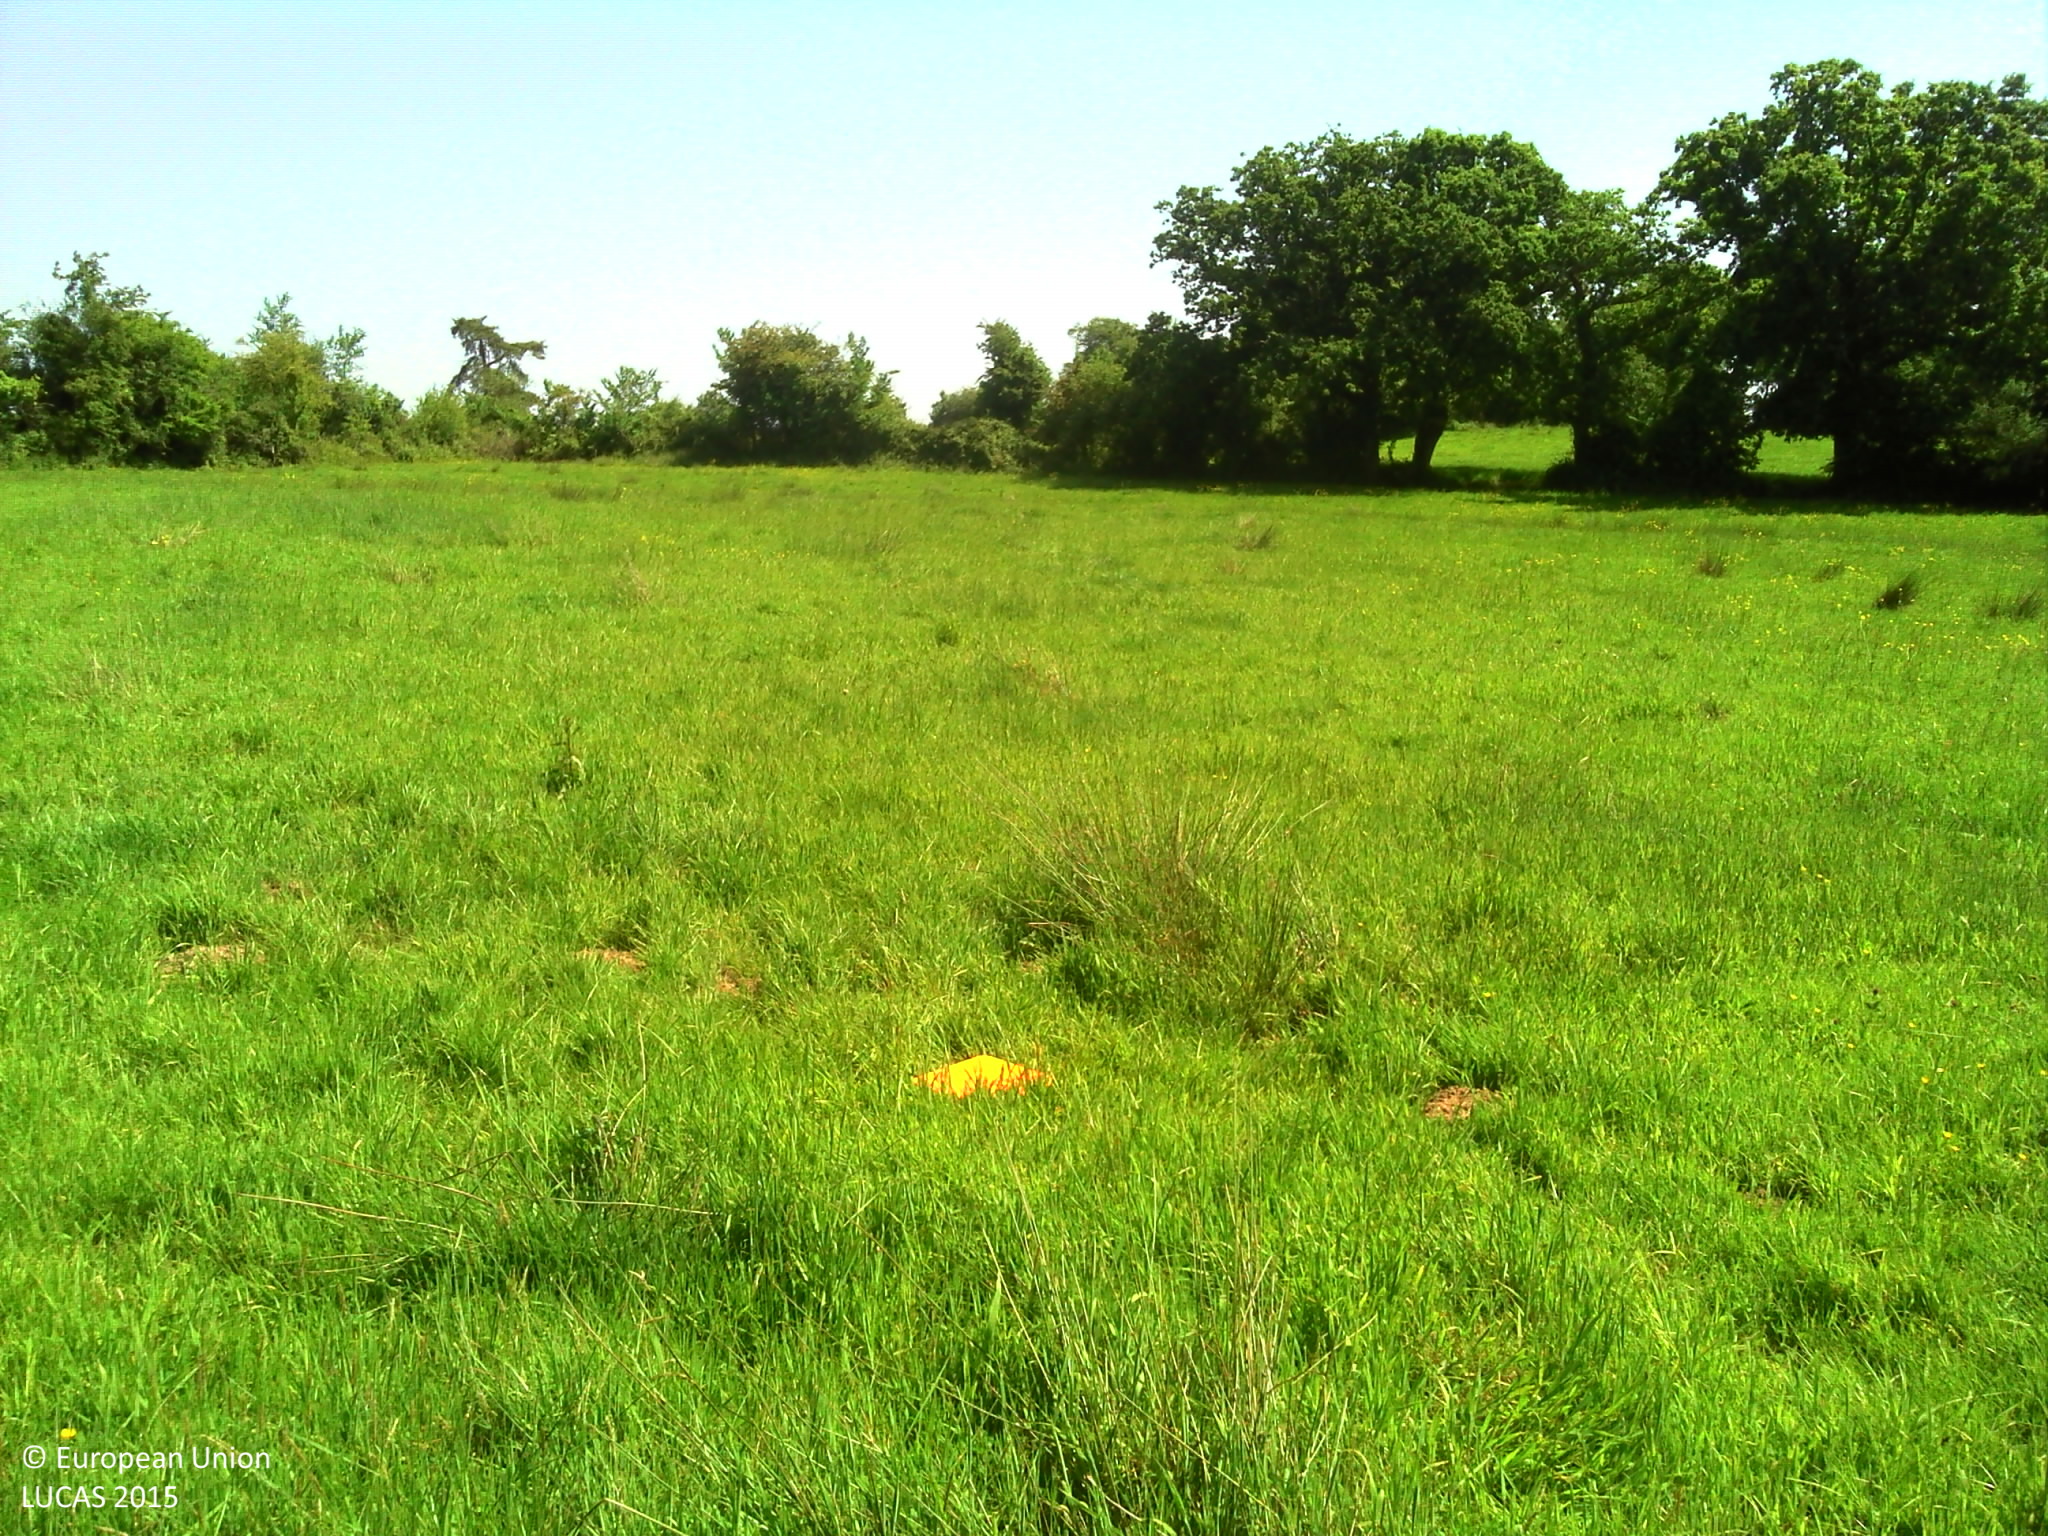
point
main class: Grassland
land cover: Grassland without tree/shrub cover
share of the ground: > 75 %
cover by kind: herbaceous plants 100 %
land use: Agriculture (excluding fallow land and kitchen gardens)
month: June
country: FR
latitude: 49.4478
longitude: -1.5677
